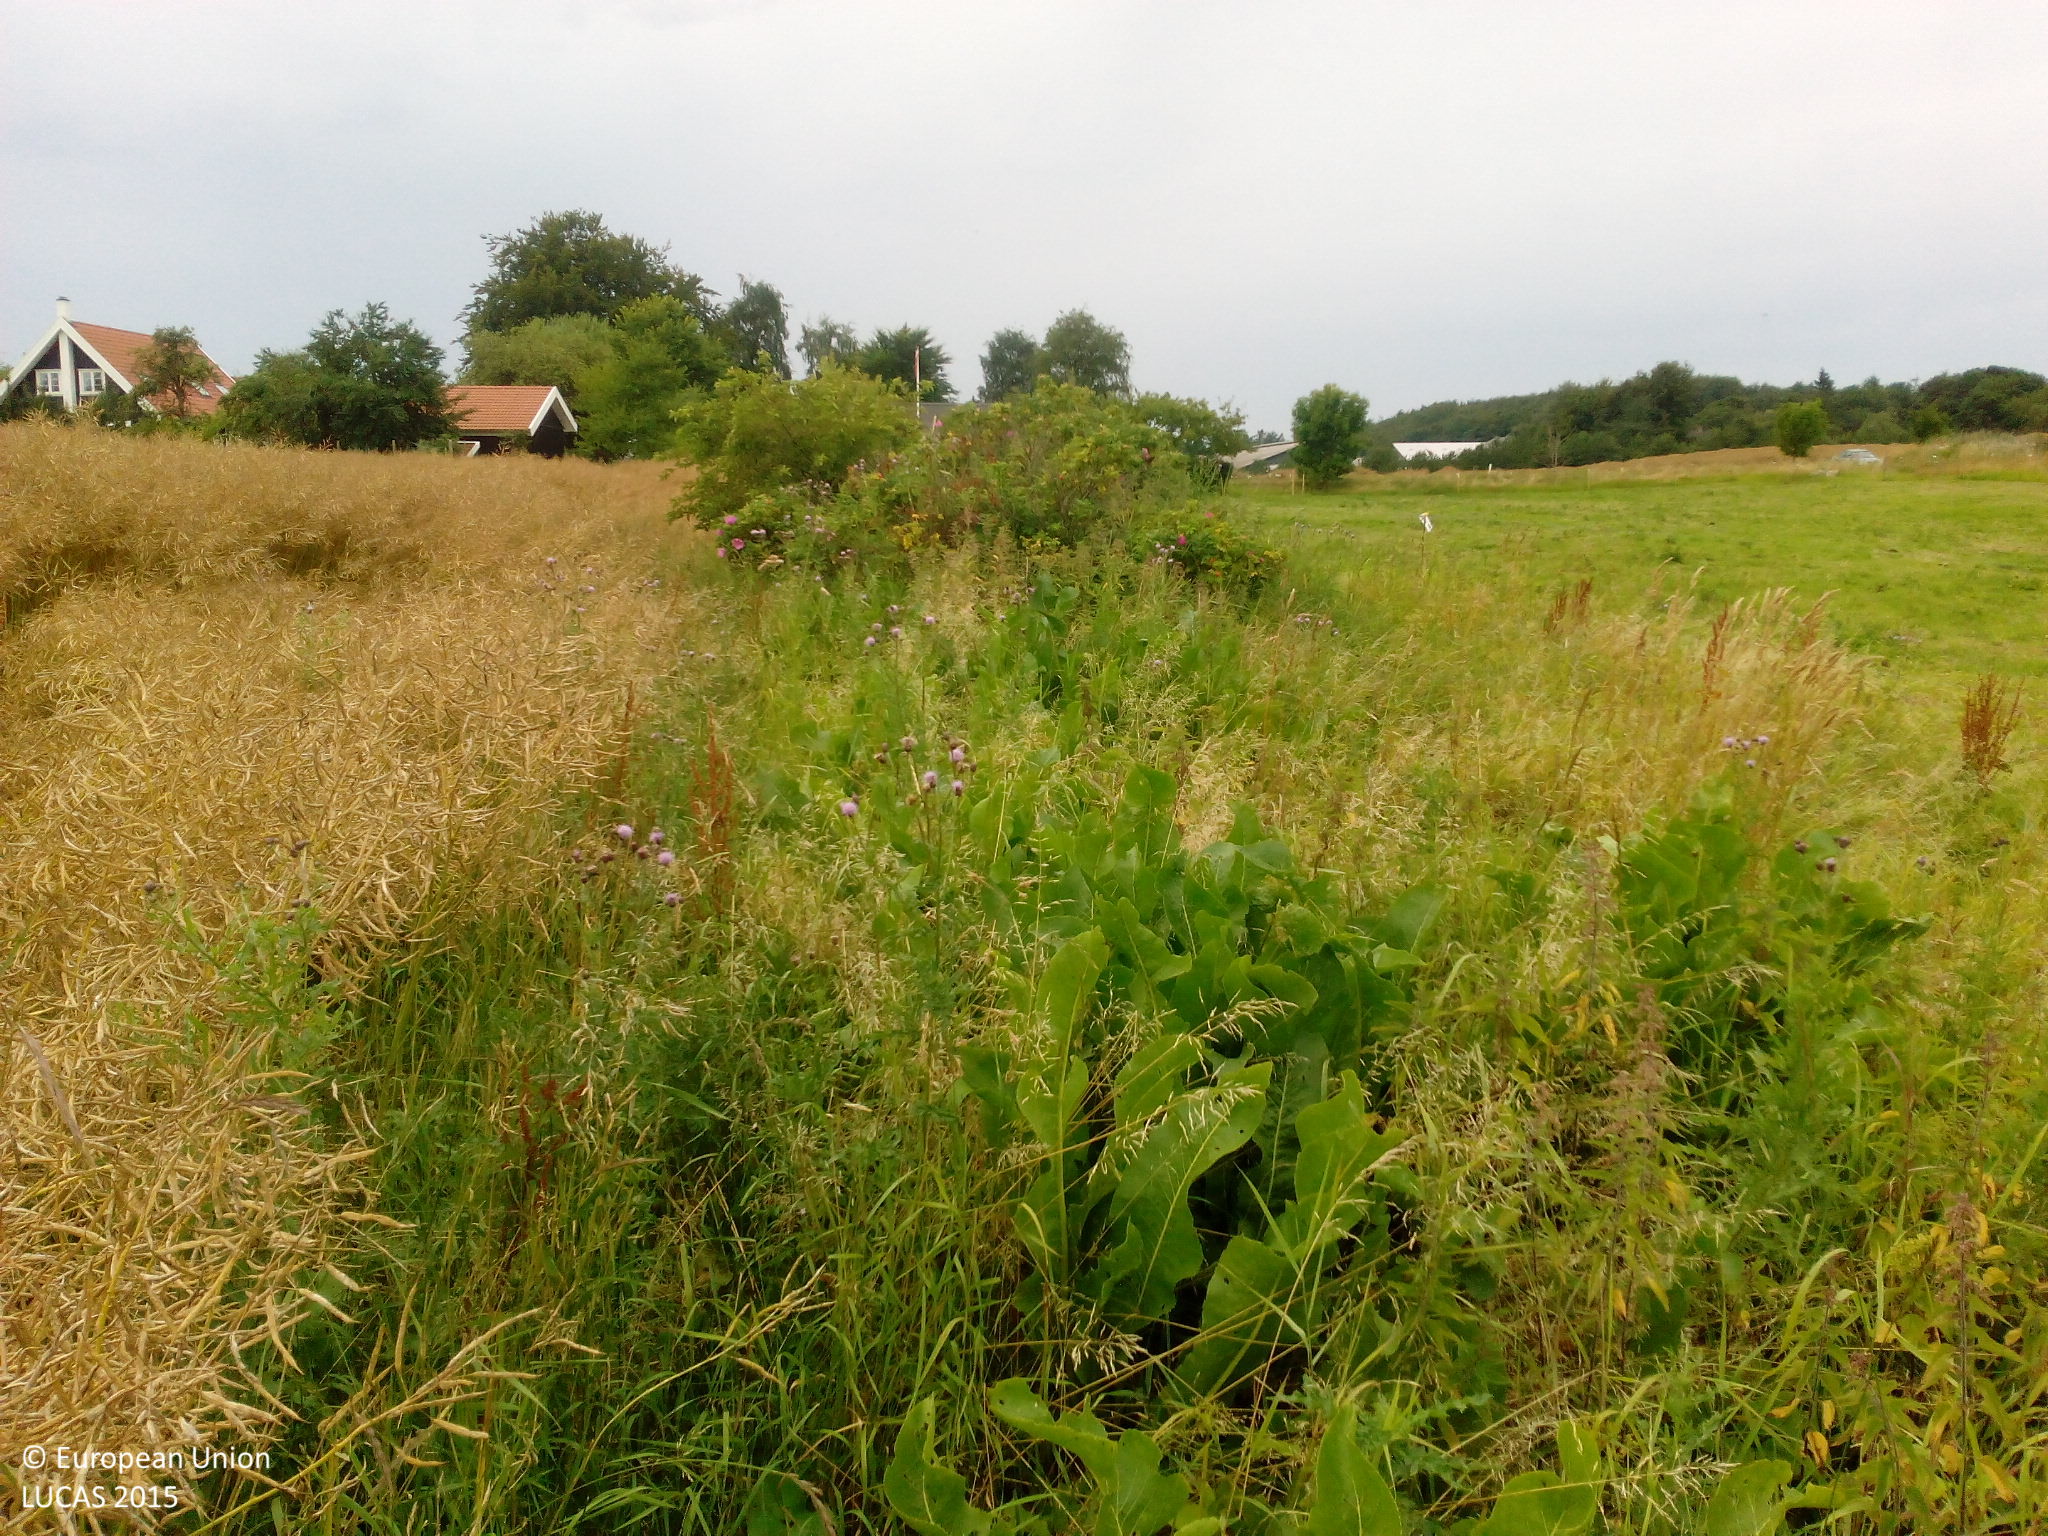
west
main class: Cropland
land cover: Rape and turnip rape
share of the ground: > 75 %
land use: Agriculture (excluding fallow land and kitchen gardens)
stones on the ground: < 10 %
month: August
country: DK
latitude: 55.5267
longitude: 11.8835
